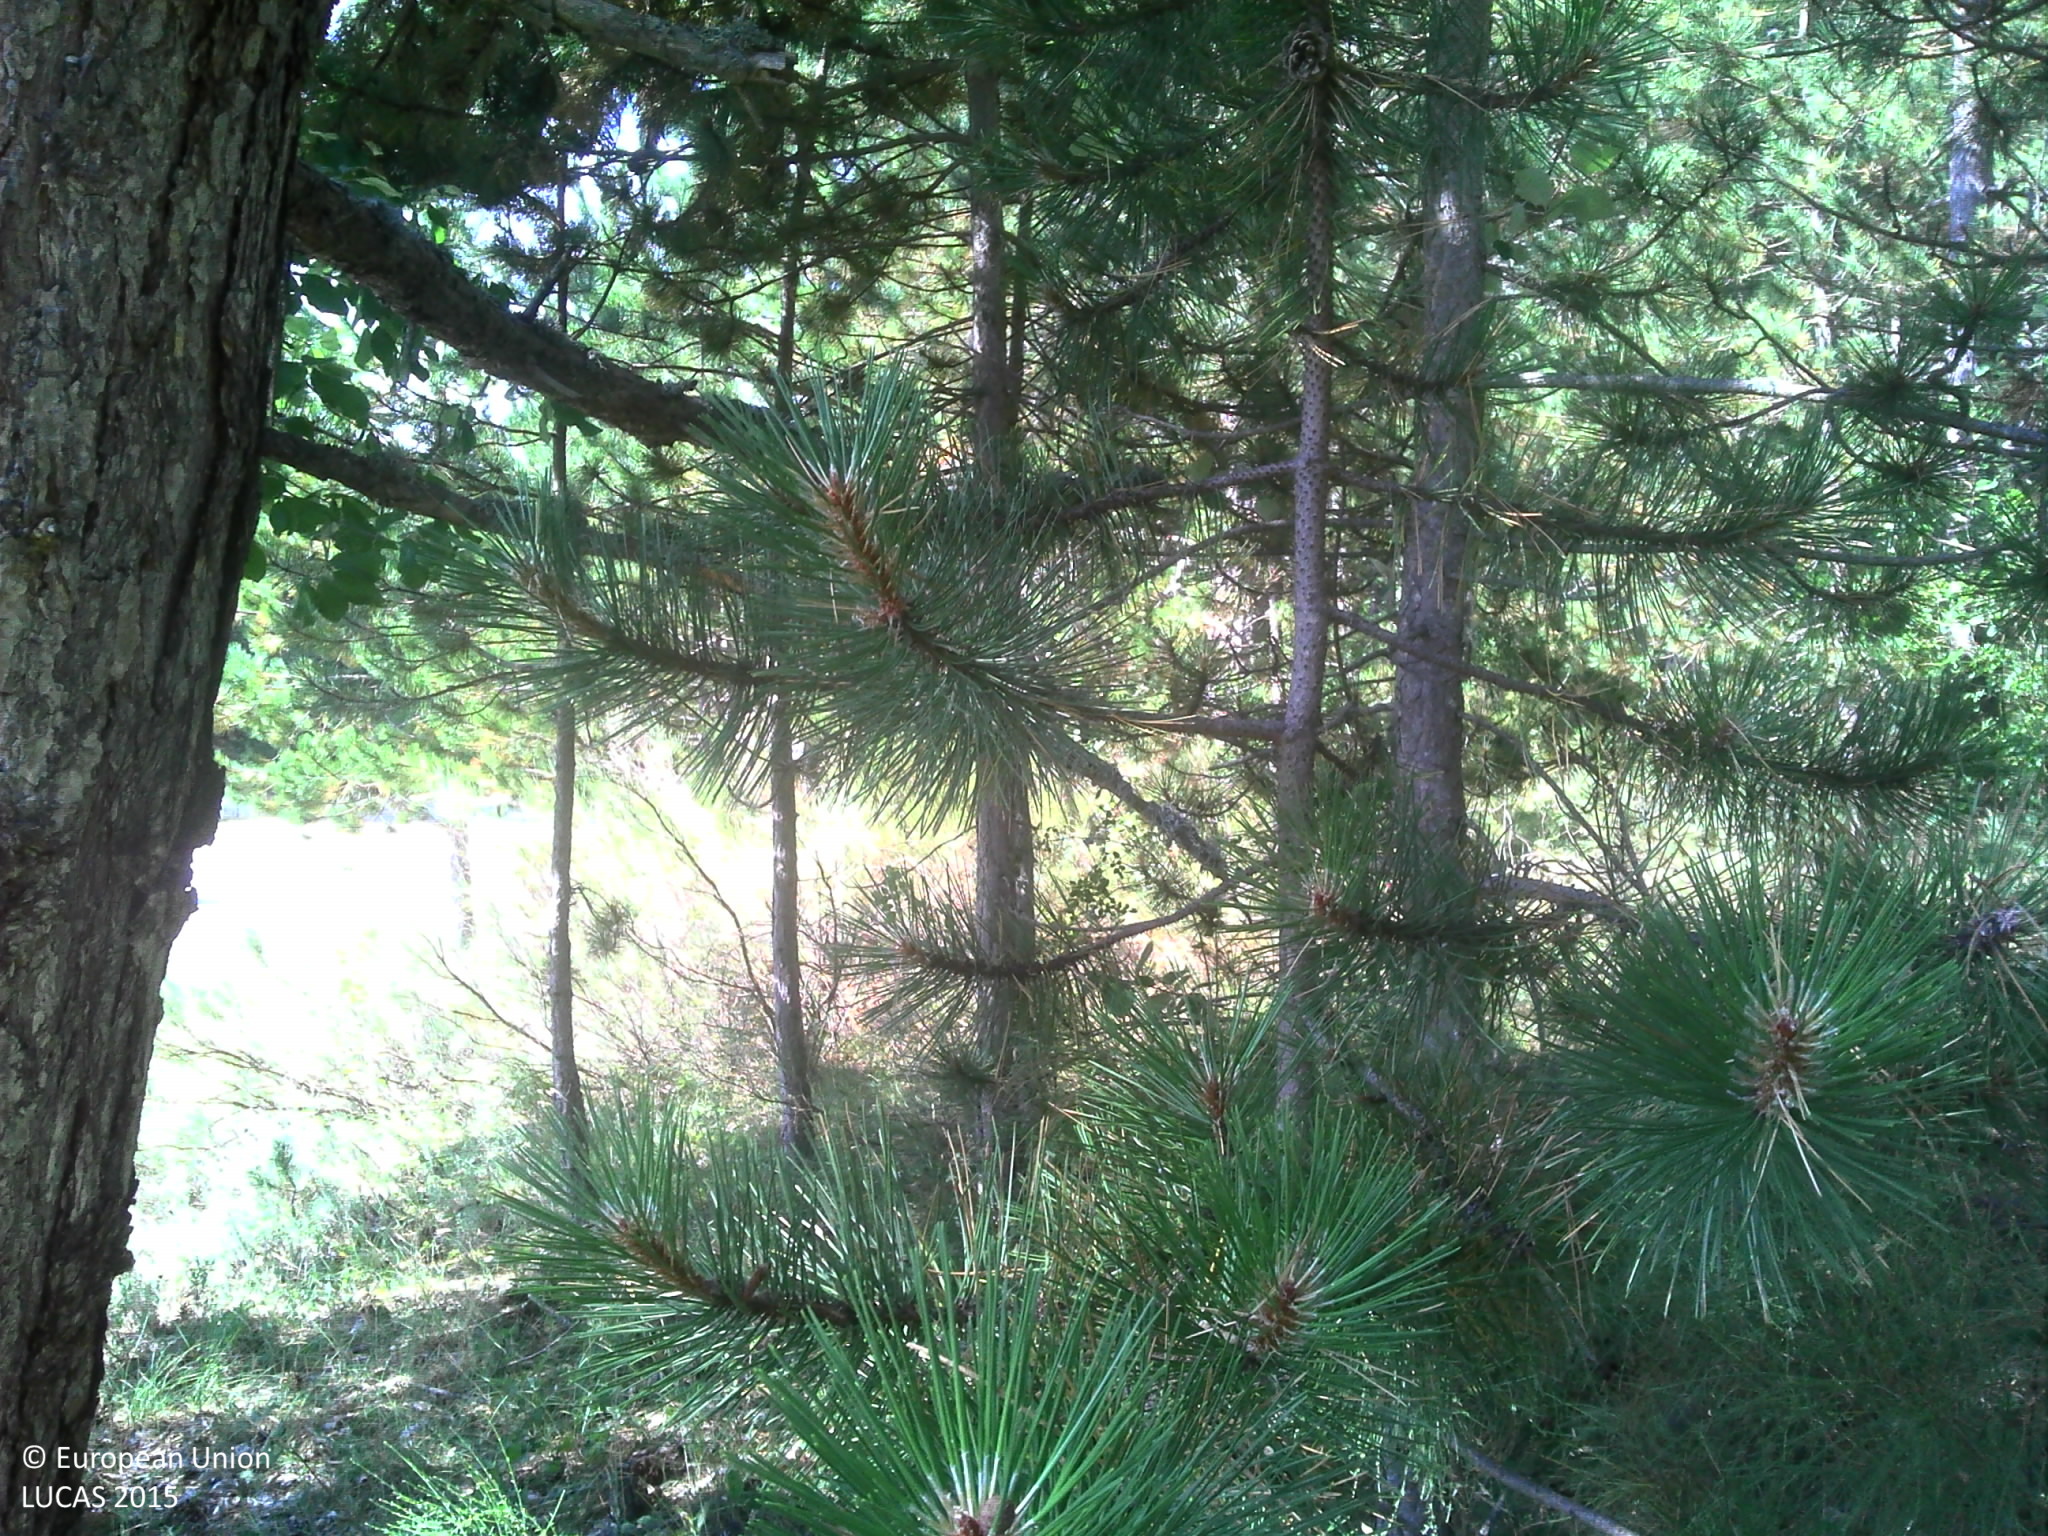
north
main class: Woodland
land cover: Pine dominated coniferous woodland
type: coniferous forest of the mediterranean region
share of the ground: > 75 %
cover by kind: coniferous forest trees 65 %
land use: Forestry
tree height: > 5 m
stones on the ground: < 10 %
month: July
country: FR
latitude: 44.1476
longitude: 5.5697
